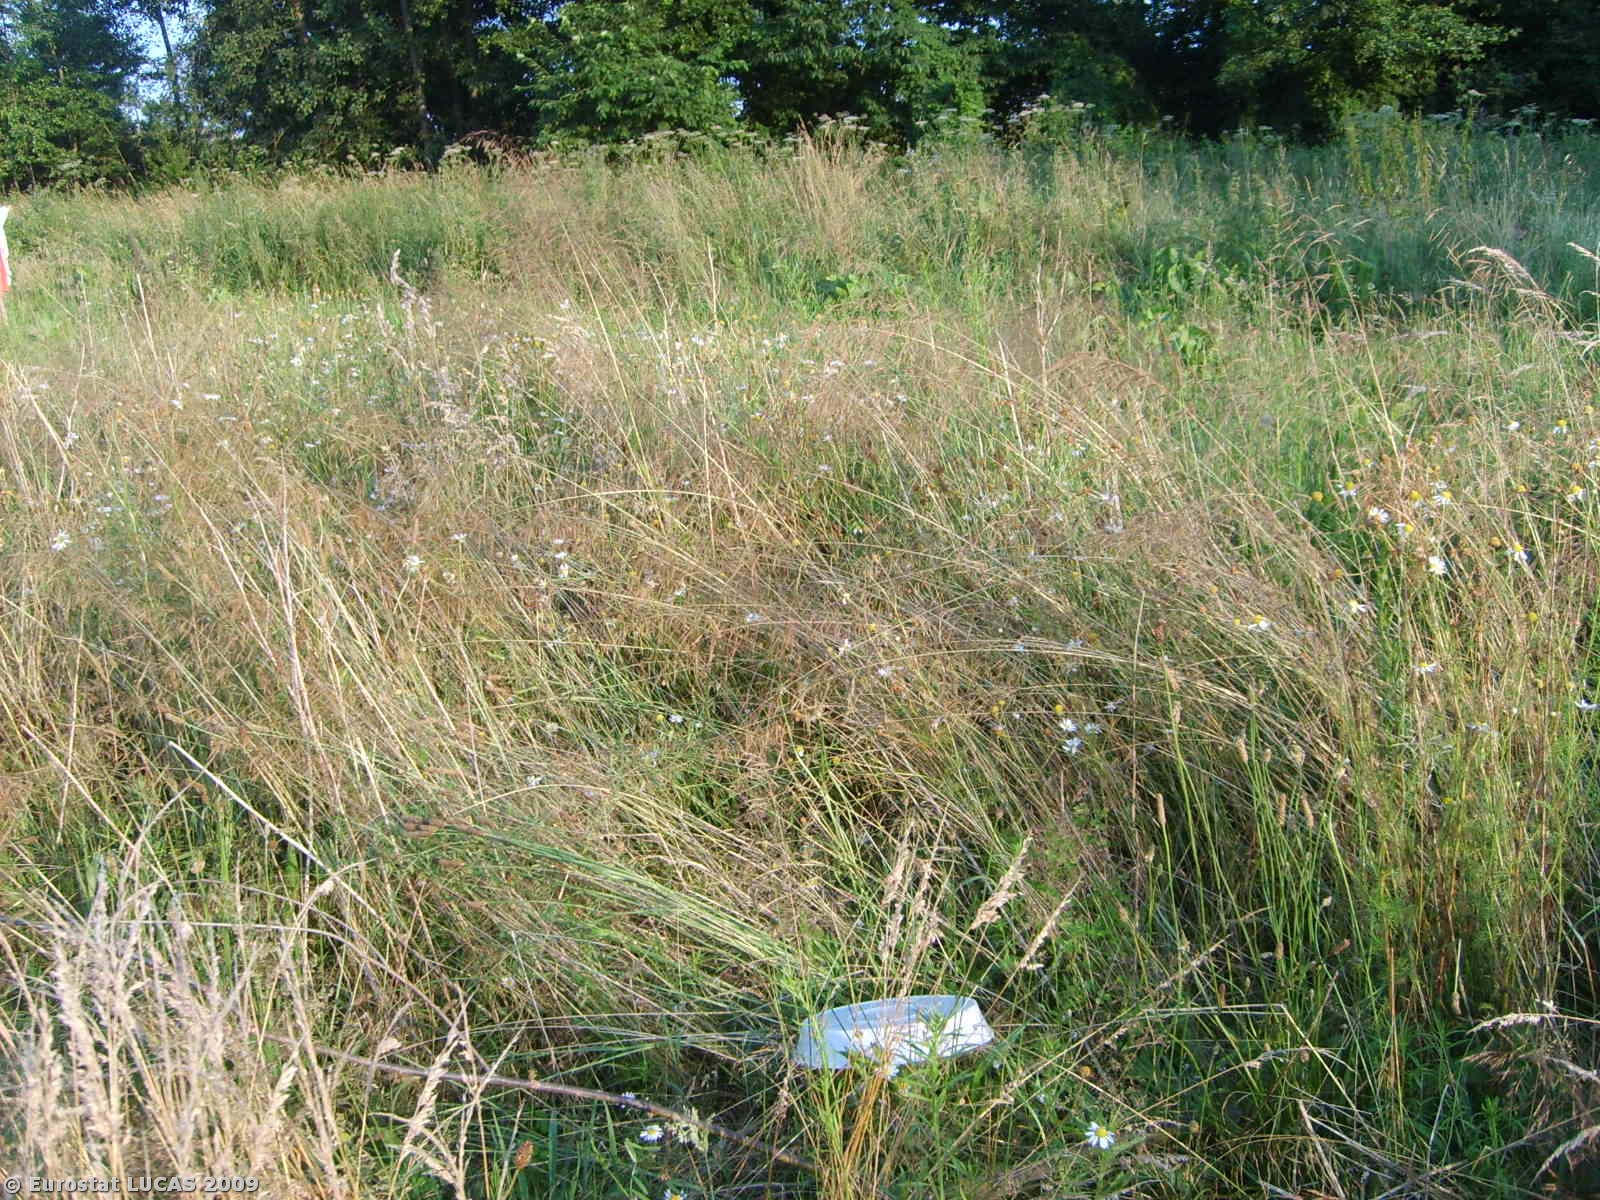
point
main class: Grassland
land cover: Grassland without tree/shrub cover
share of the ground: > 75 %
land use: Agriculture (excluding fallow land and kitchen gardens)
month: July
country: PL
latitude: 52.1596
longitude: 21.7045
